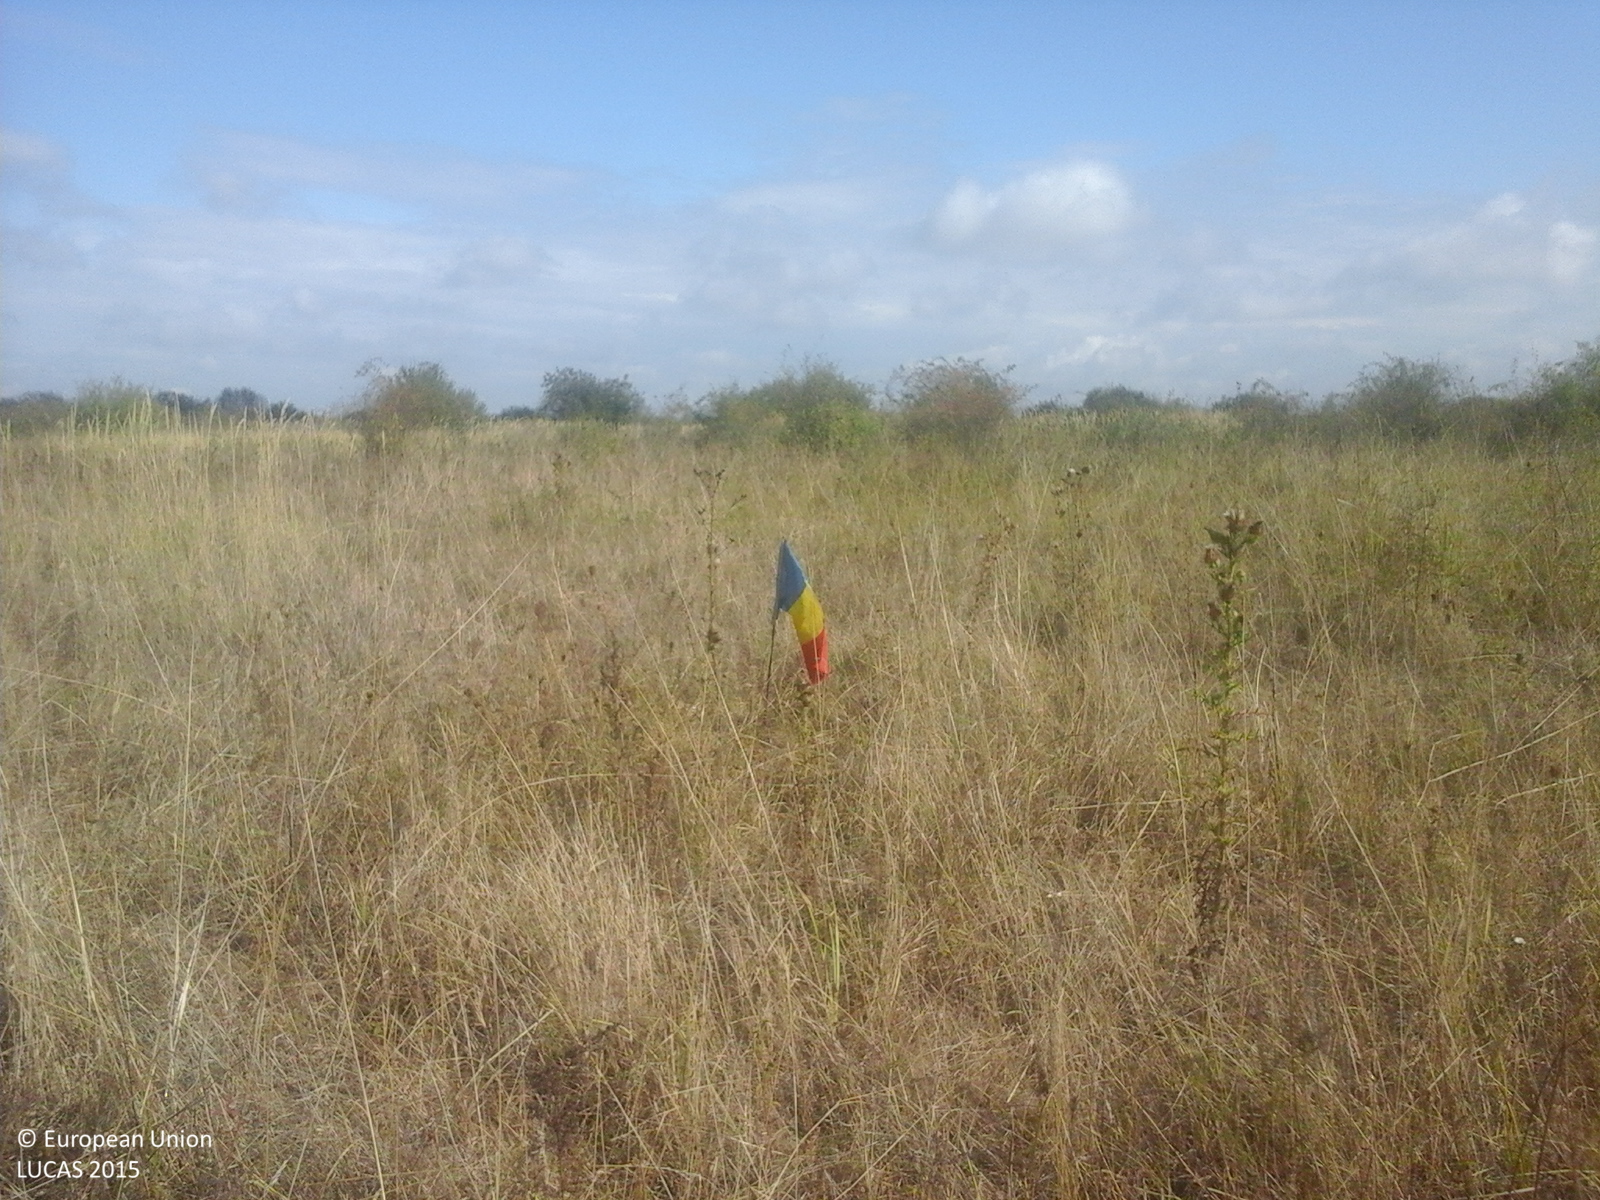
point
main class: Grassland
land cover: Spontaneously vegetated surfaces
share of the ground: > 75 %
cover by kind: herbaceous plants 100 %
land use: Fallow land
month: September
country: RO
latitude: 47.9226
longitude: 23.0085
